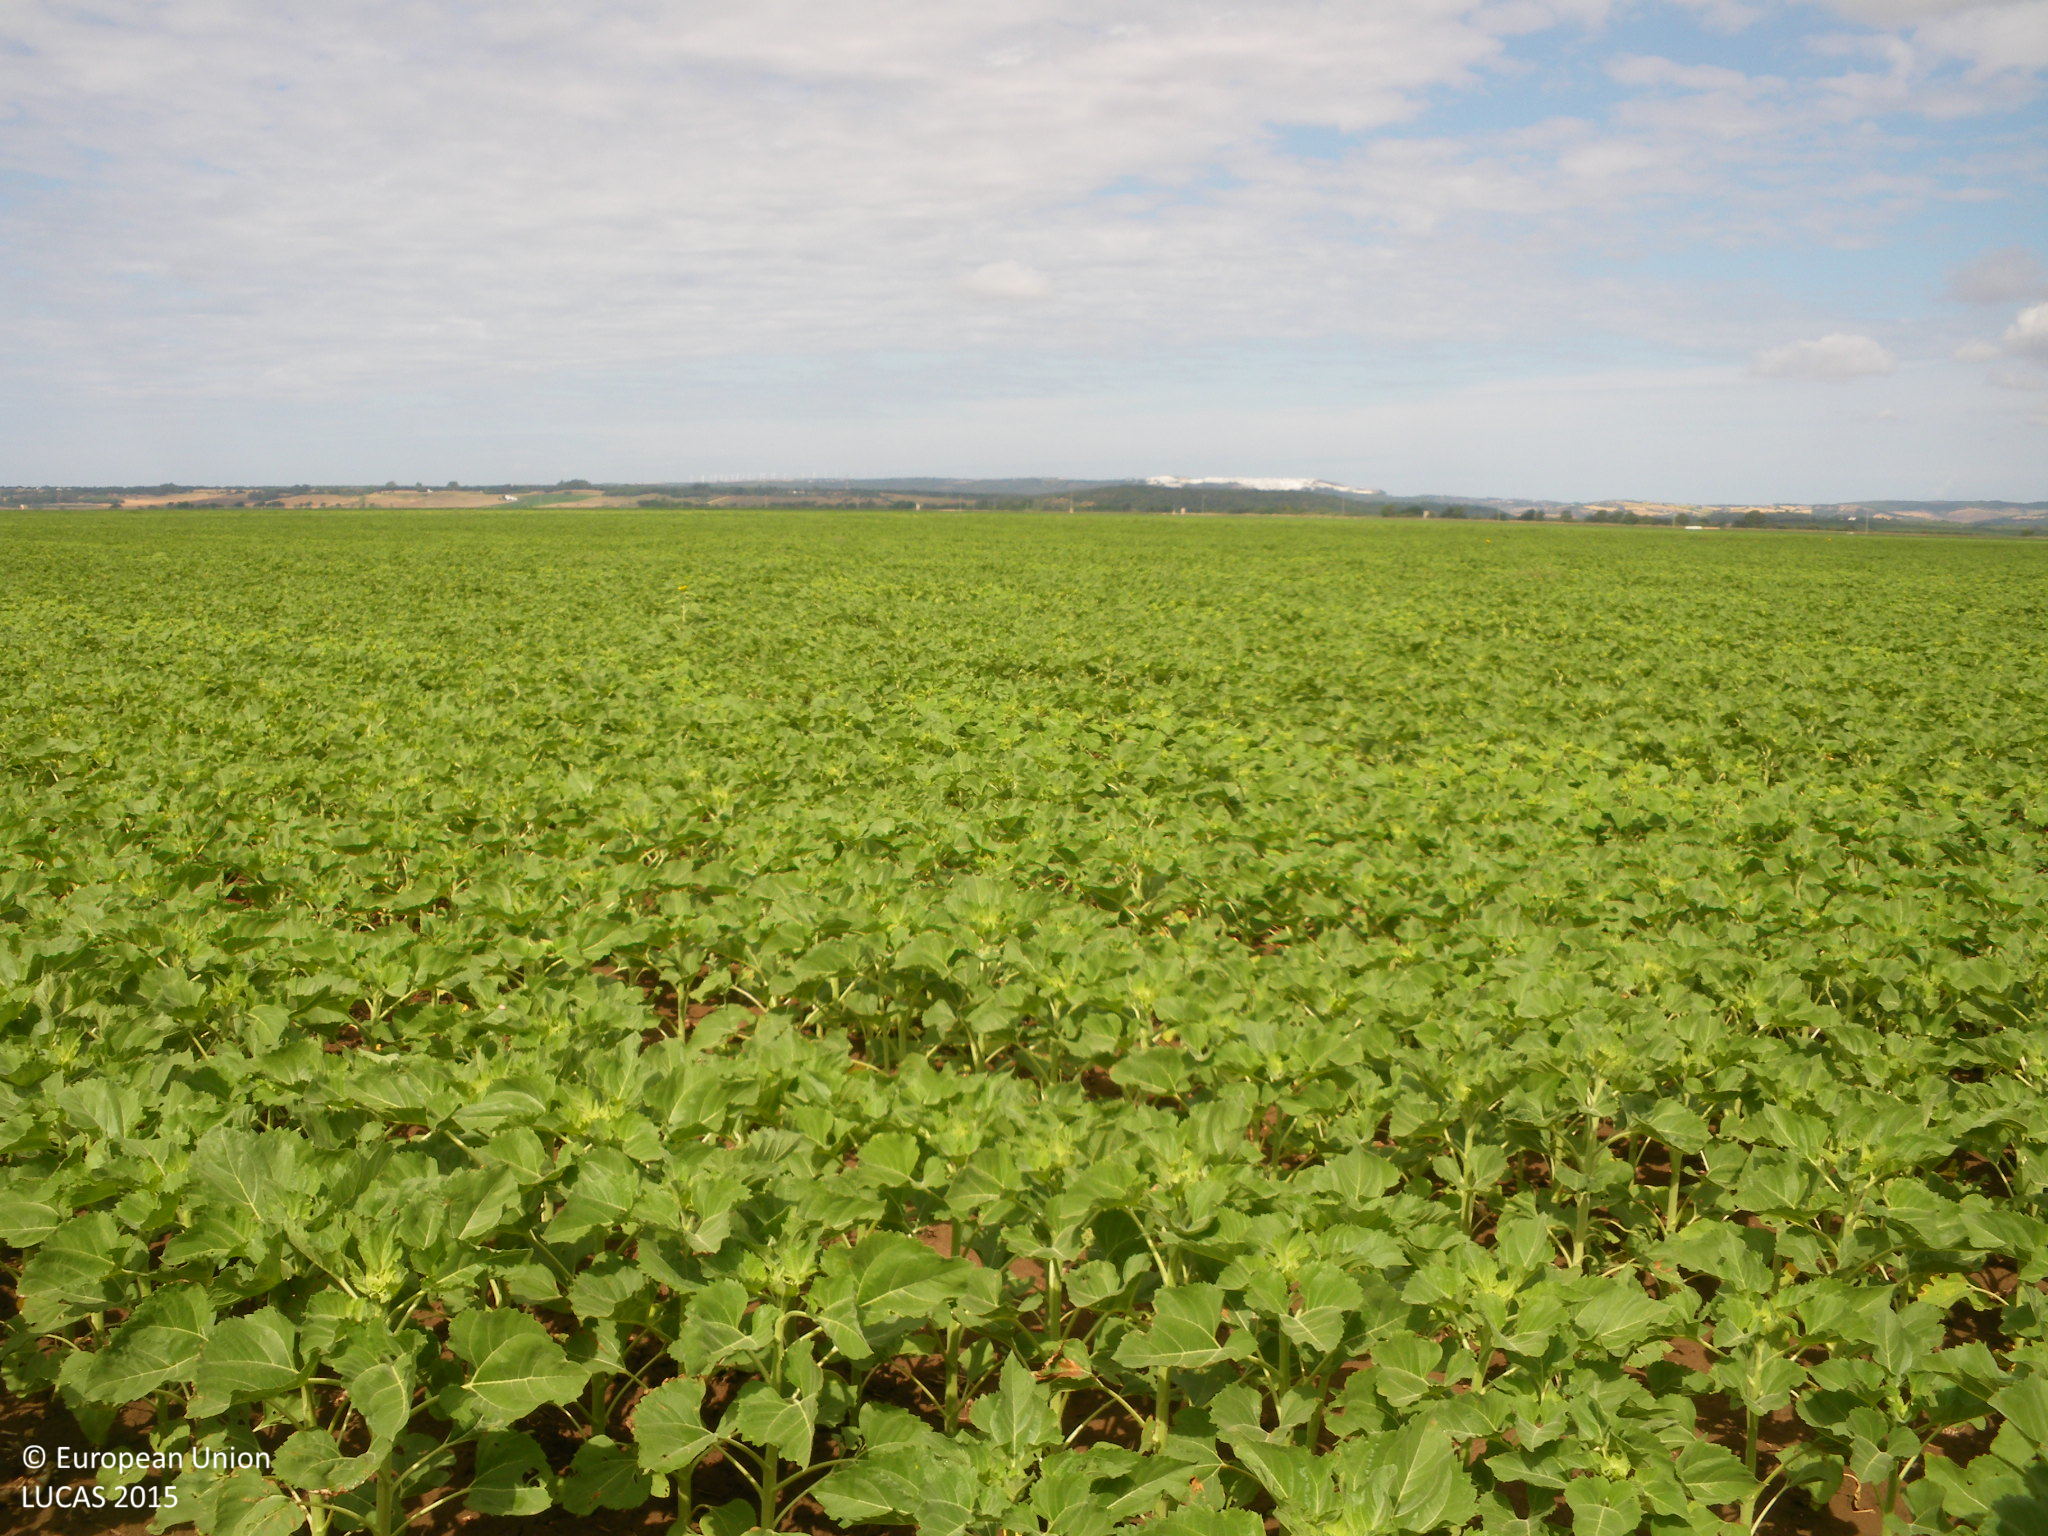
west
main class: Cropland
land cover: Sunflower
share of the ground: > 75 %
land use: Agriculture (excluding fallow land and kitchen gardens)
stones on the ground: < 10 %
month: June
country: ES
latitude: 36.2636
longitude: -5.8380
